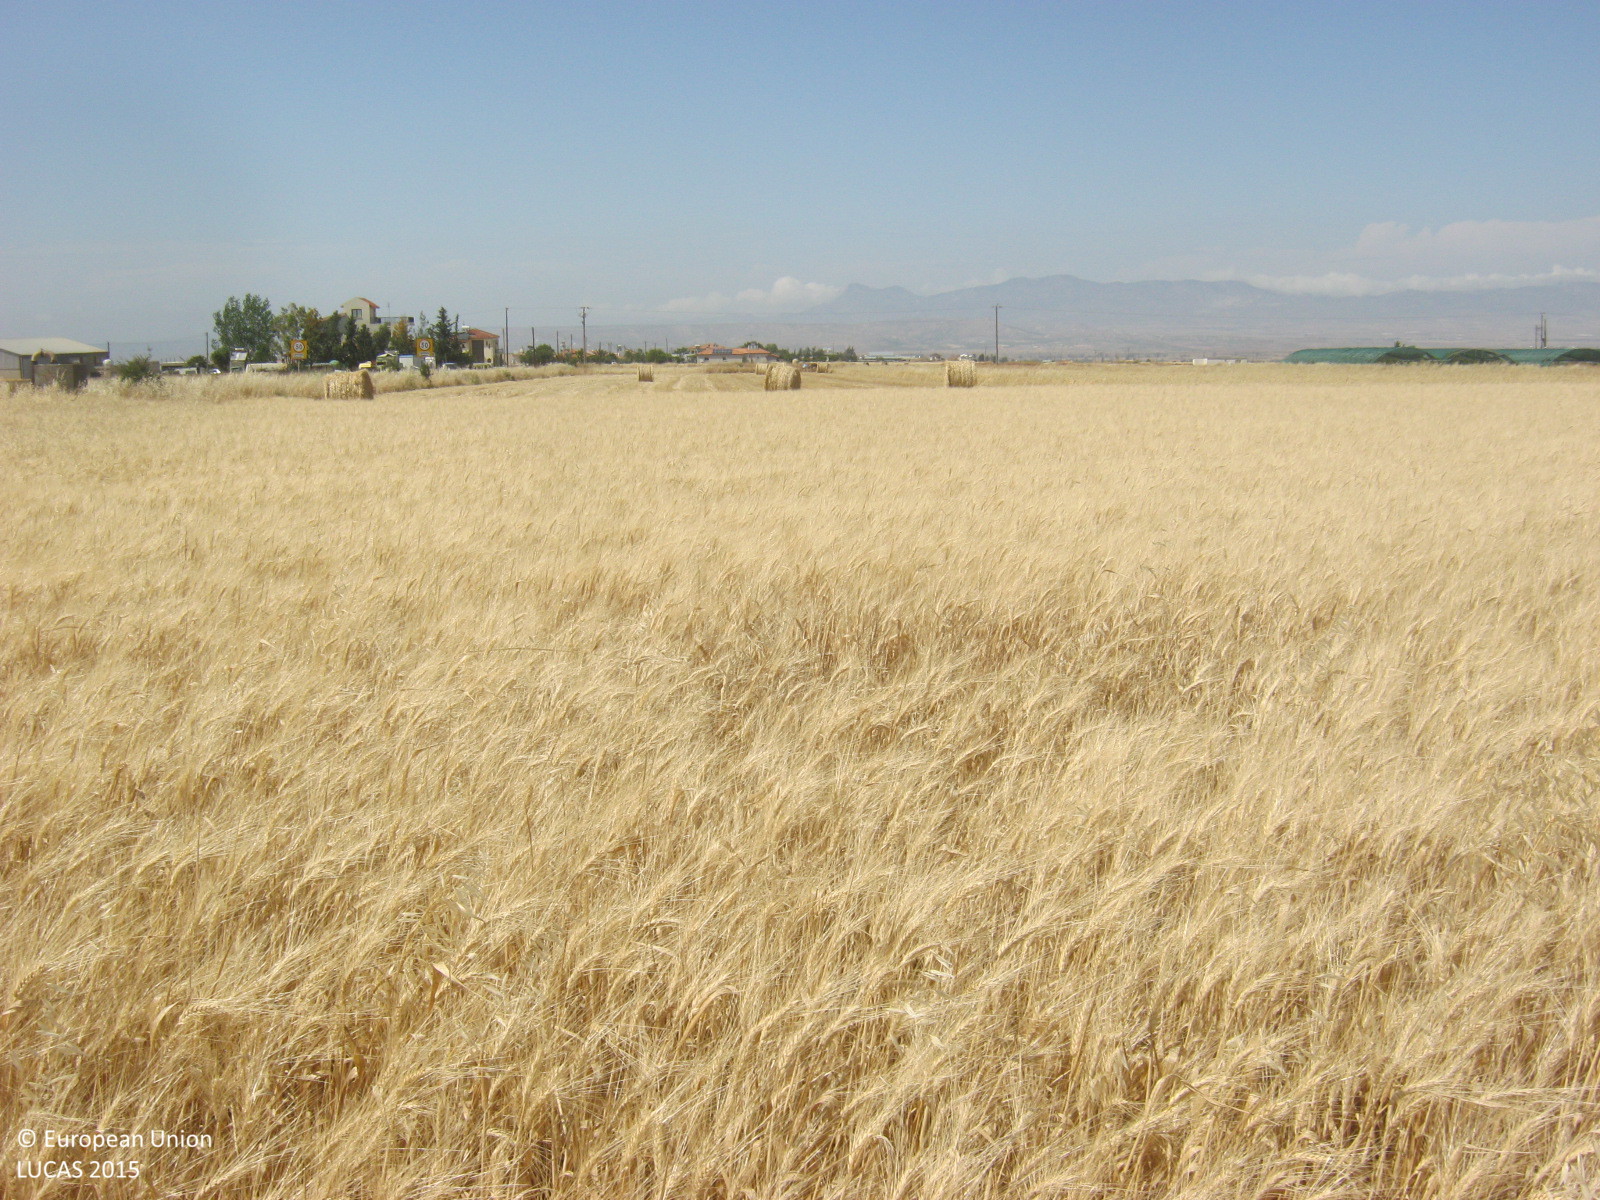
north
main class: Cropland
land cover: Mixed cereals for fodder
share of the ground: > 75 %
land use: Agriculture (excluding fallow land and kitchen gardens)
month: May
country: CY
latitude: 35.0887
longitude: 33.0940
